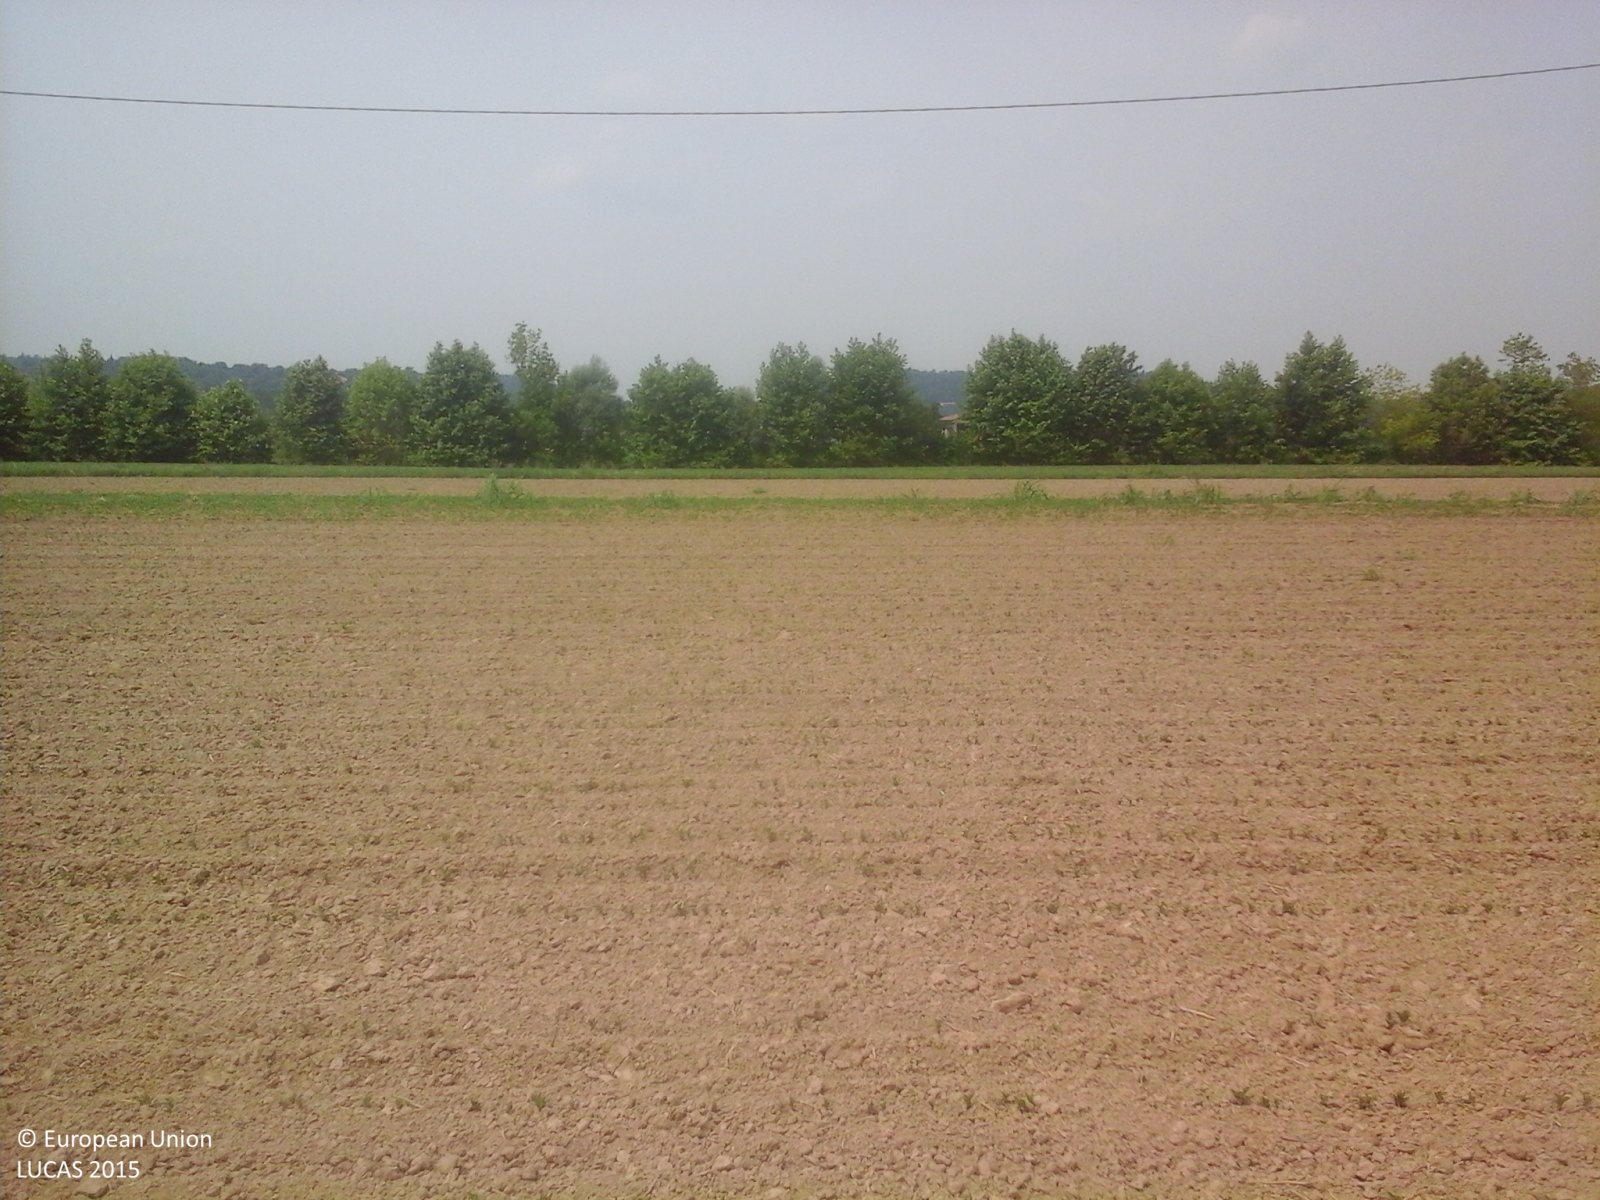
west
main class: Cropland
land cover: Soya
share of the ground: < 10 %
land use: Agriculture (excluding fallow land and kitchen gardens)
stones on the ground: < 10 %
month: June
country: IT
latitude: 45.3826
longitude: 11.6957
